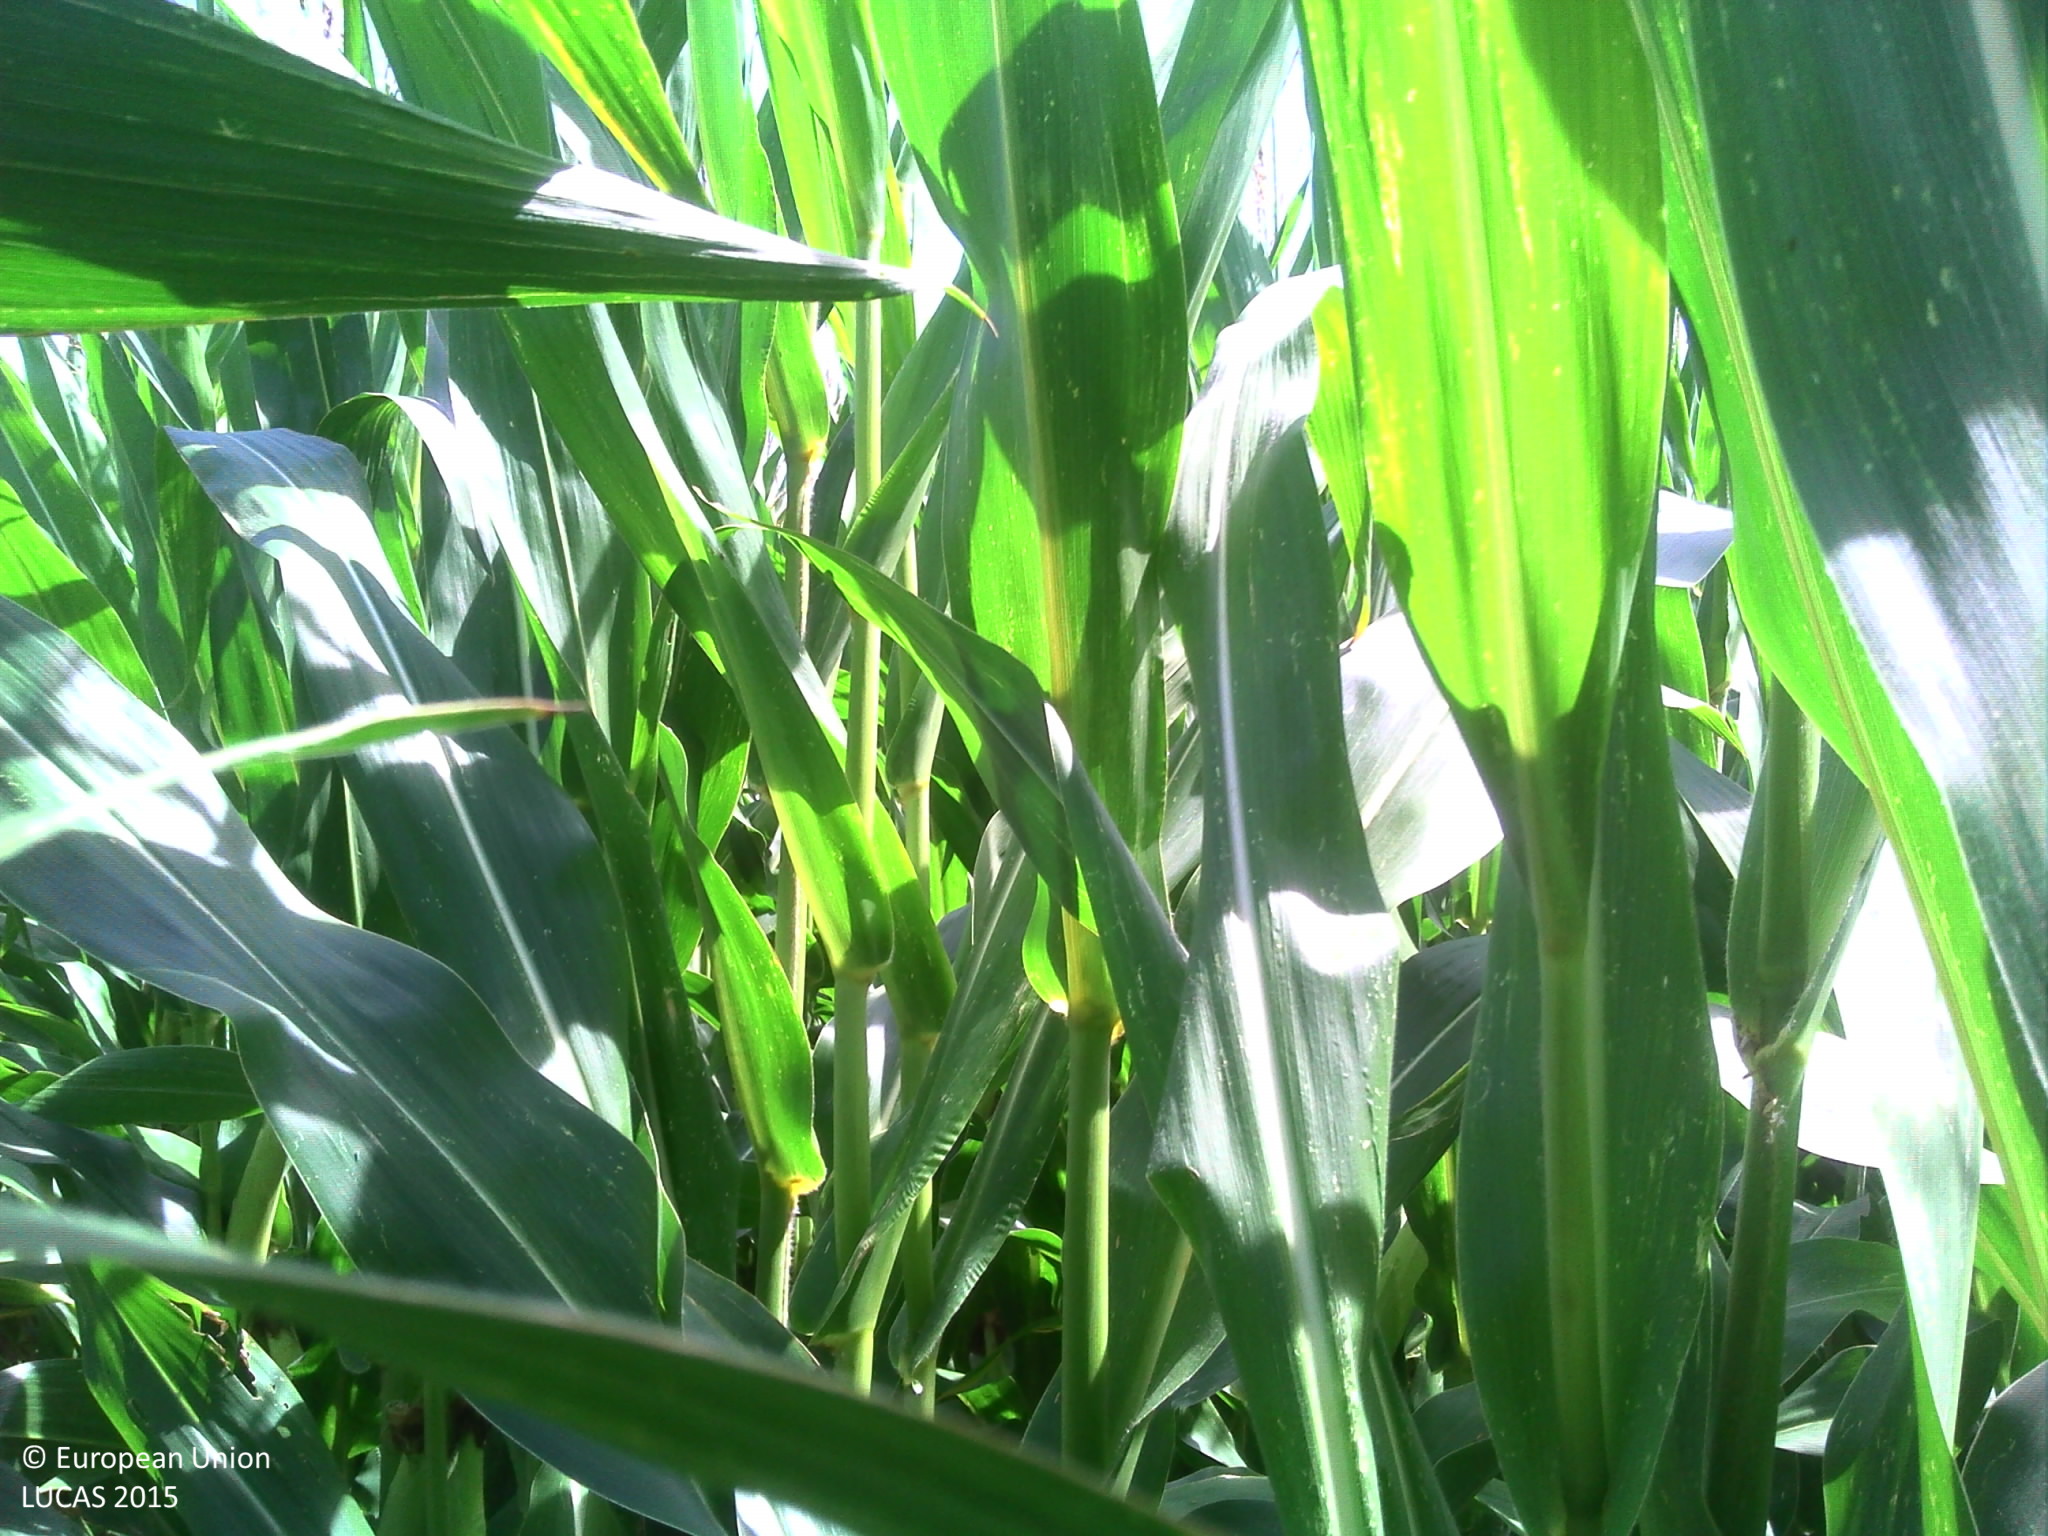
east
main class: Cropland
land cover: Maize
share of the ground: > 75 %
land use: Agriculture (excluding fallow land and kitchen gardens)
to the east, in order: Maize; Electric lines; Maize; Lines of trees; Ditches and canals; Grass margins; Tracks; Ditches and canals; Common wheat; Artificial constructions in urban areas; Ditches and canals; Paved roads, cycling and walking lanes; Grass margins; Ditches and canals; Common wheat
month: August
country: FR
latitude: 46.7665
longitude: -1.6558
